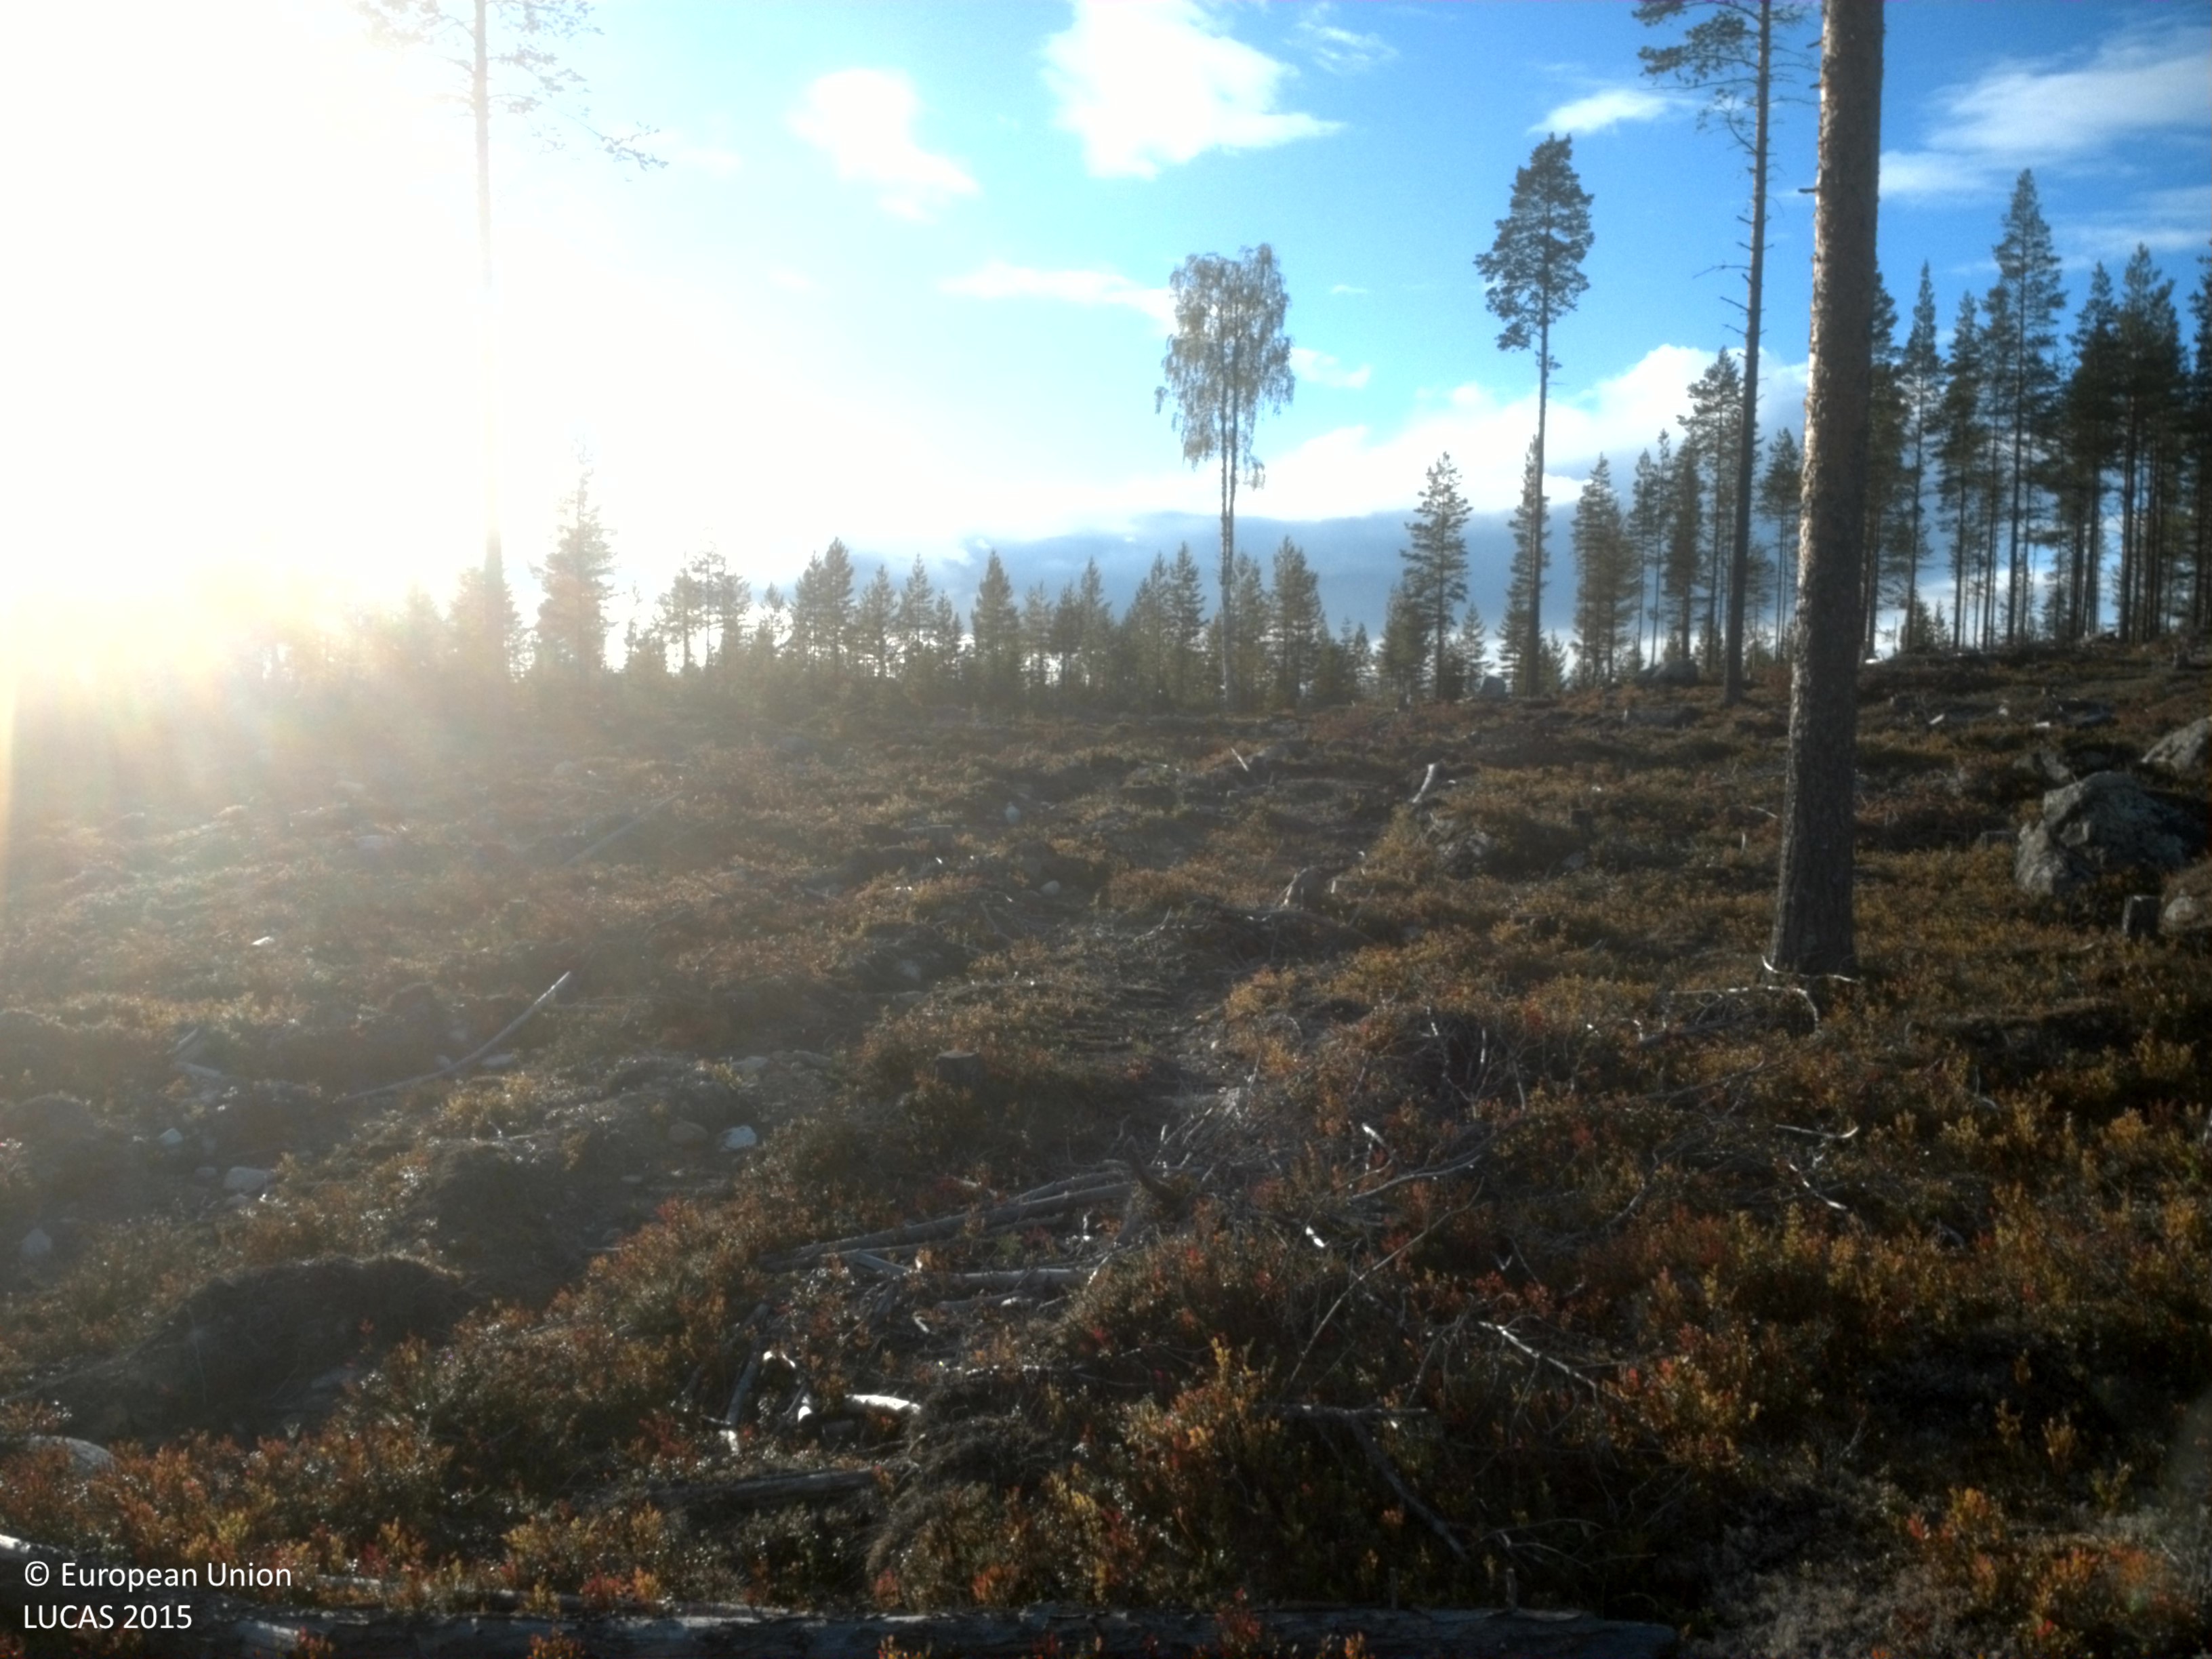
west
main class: Woodland
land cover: Pine dominated coniferous woodland
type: boreal forest
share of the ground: 10 - 25 %
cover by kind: shrubs 75 %, lichens and mosses 15 %, coniferous forest trees 10 %
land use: Forestry
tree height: > 5 m
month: September
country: SE
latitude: 64.4458
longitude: 19.7177
